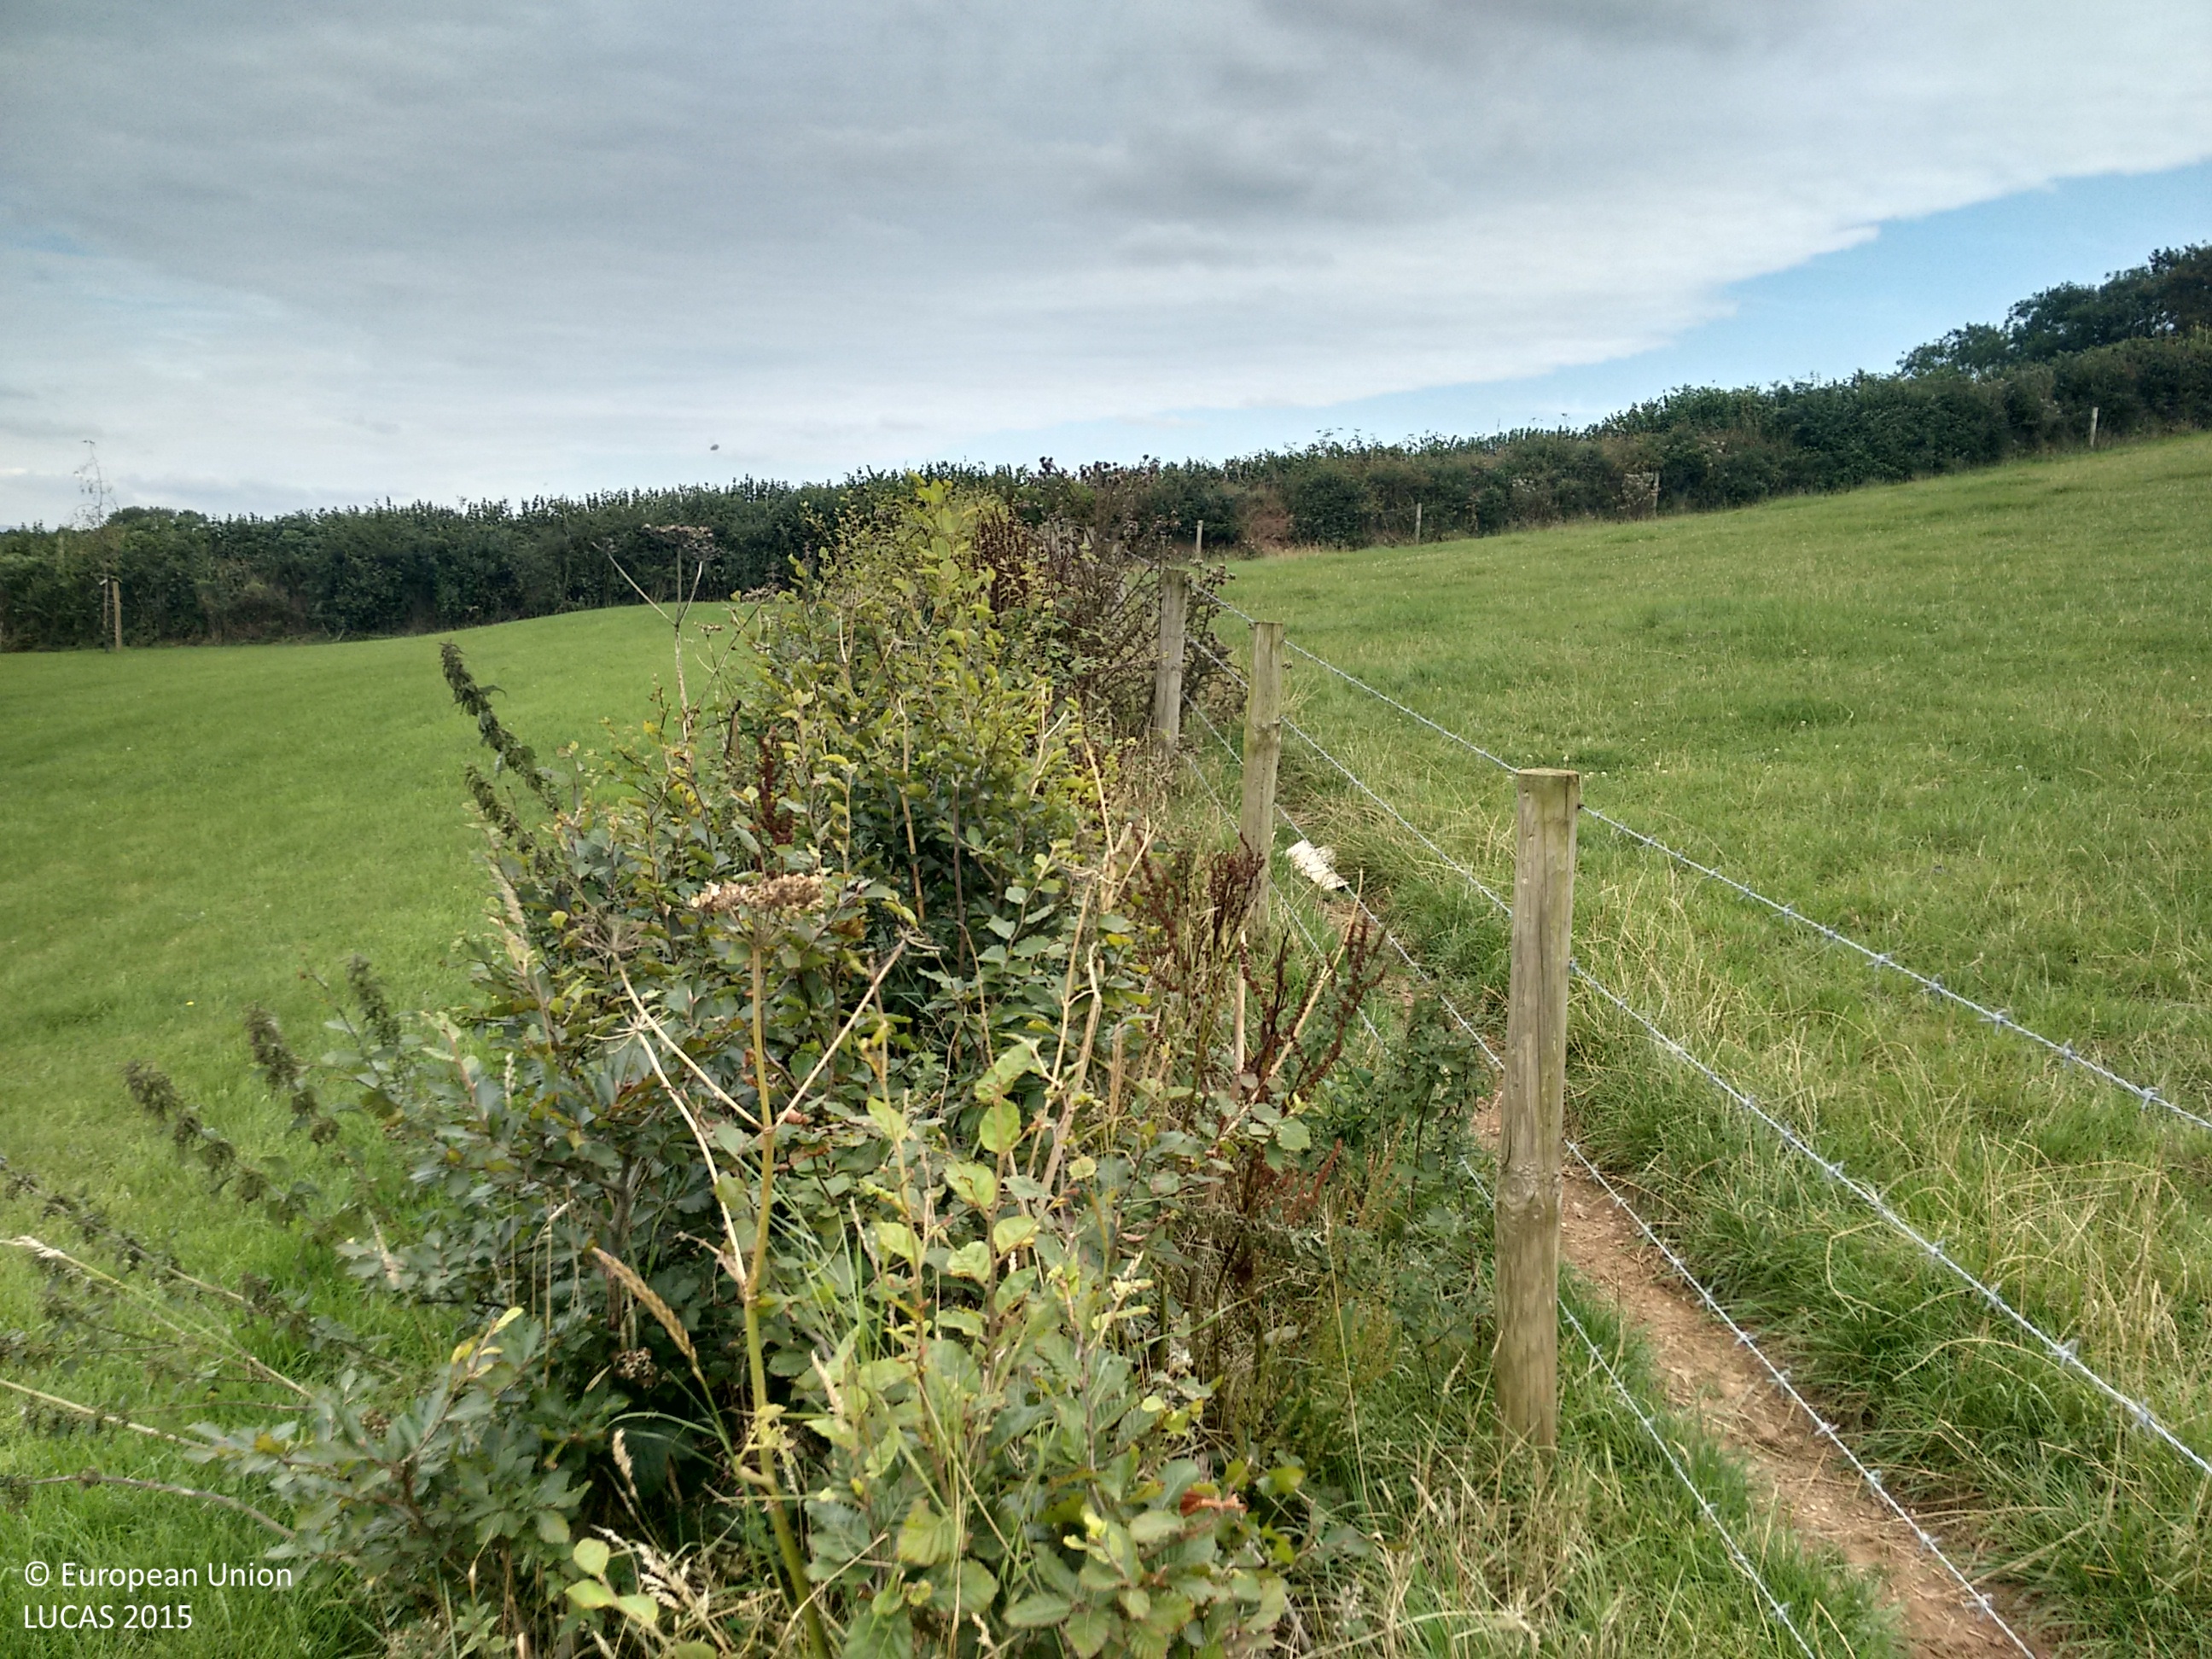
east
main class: Grassland
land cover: Grassland without tree/shrub cover
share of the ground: > 75 %
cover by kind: herbaceous plants 100 %
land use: Agriculture (excluding fallow land and kitchen gardens)
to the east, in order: Grassland without tree/shrub cover; Fences; Managed hedges; Fences; Grassland without tree/shrub cover; Tracks; Grass margins; Fences; Managed hedges; Barley
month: August
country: GB
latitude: 50.4131
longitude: -4.2702
